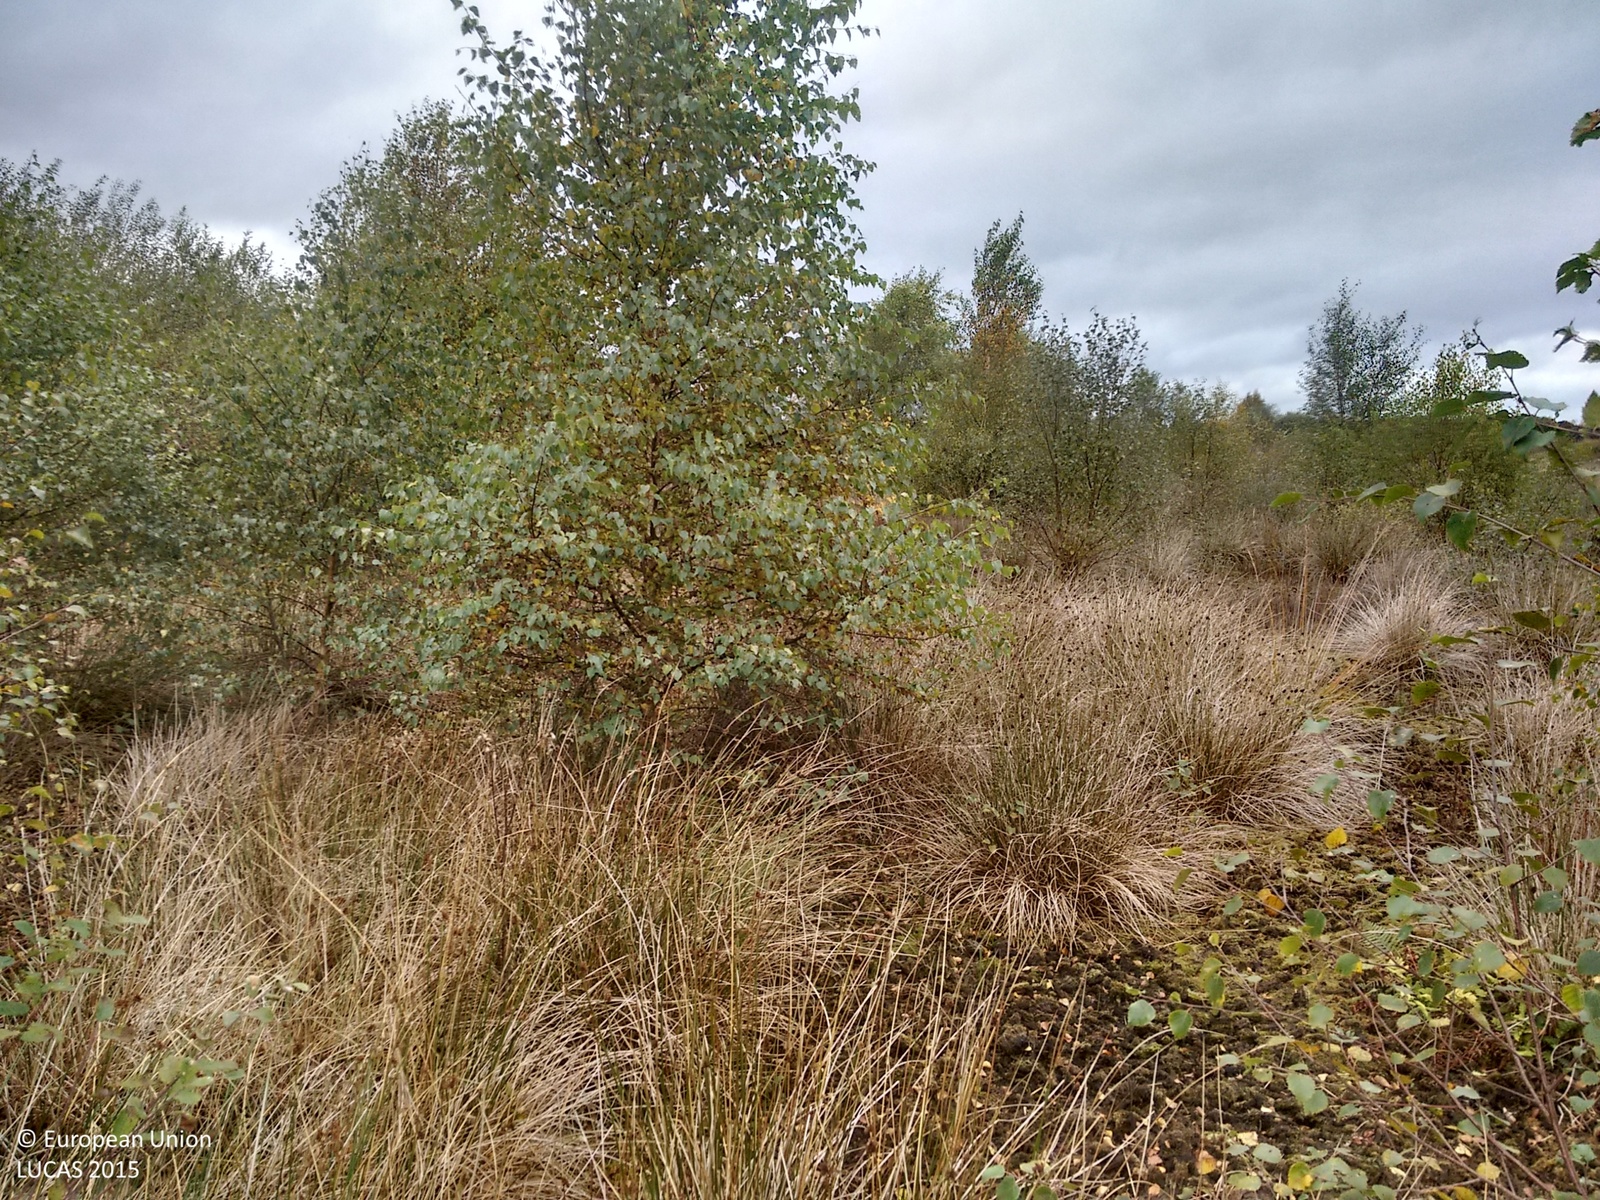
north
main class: Woodland
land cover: Broadleaved woodland
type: acidophilous oak and oak-birch forest
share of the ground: > 75 %
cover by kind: broadleaved forest trees 75 %, herbaceous plants 20 %, lichens and mosses 5 %
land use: Semi-natural and natural areas not in use
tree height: > 5 m
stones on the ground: < 10 %
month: October
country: IE
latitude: 53.1856
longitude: -7.8436
